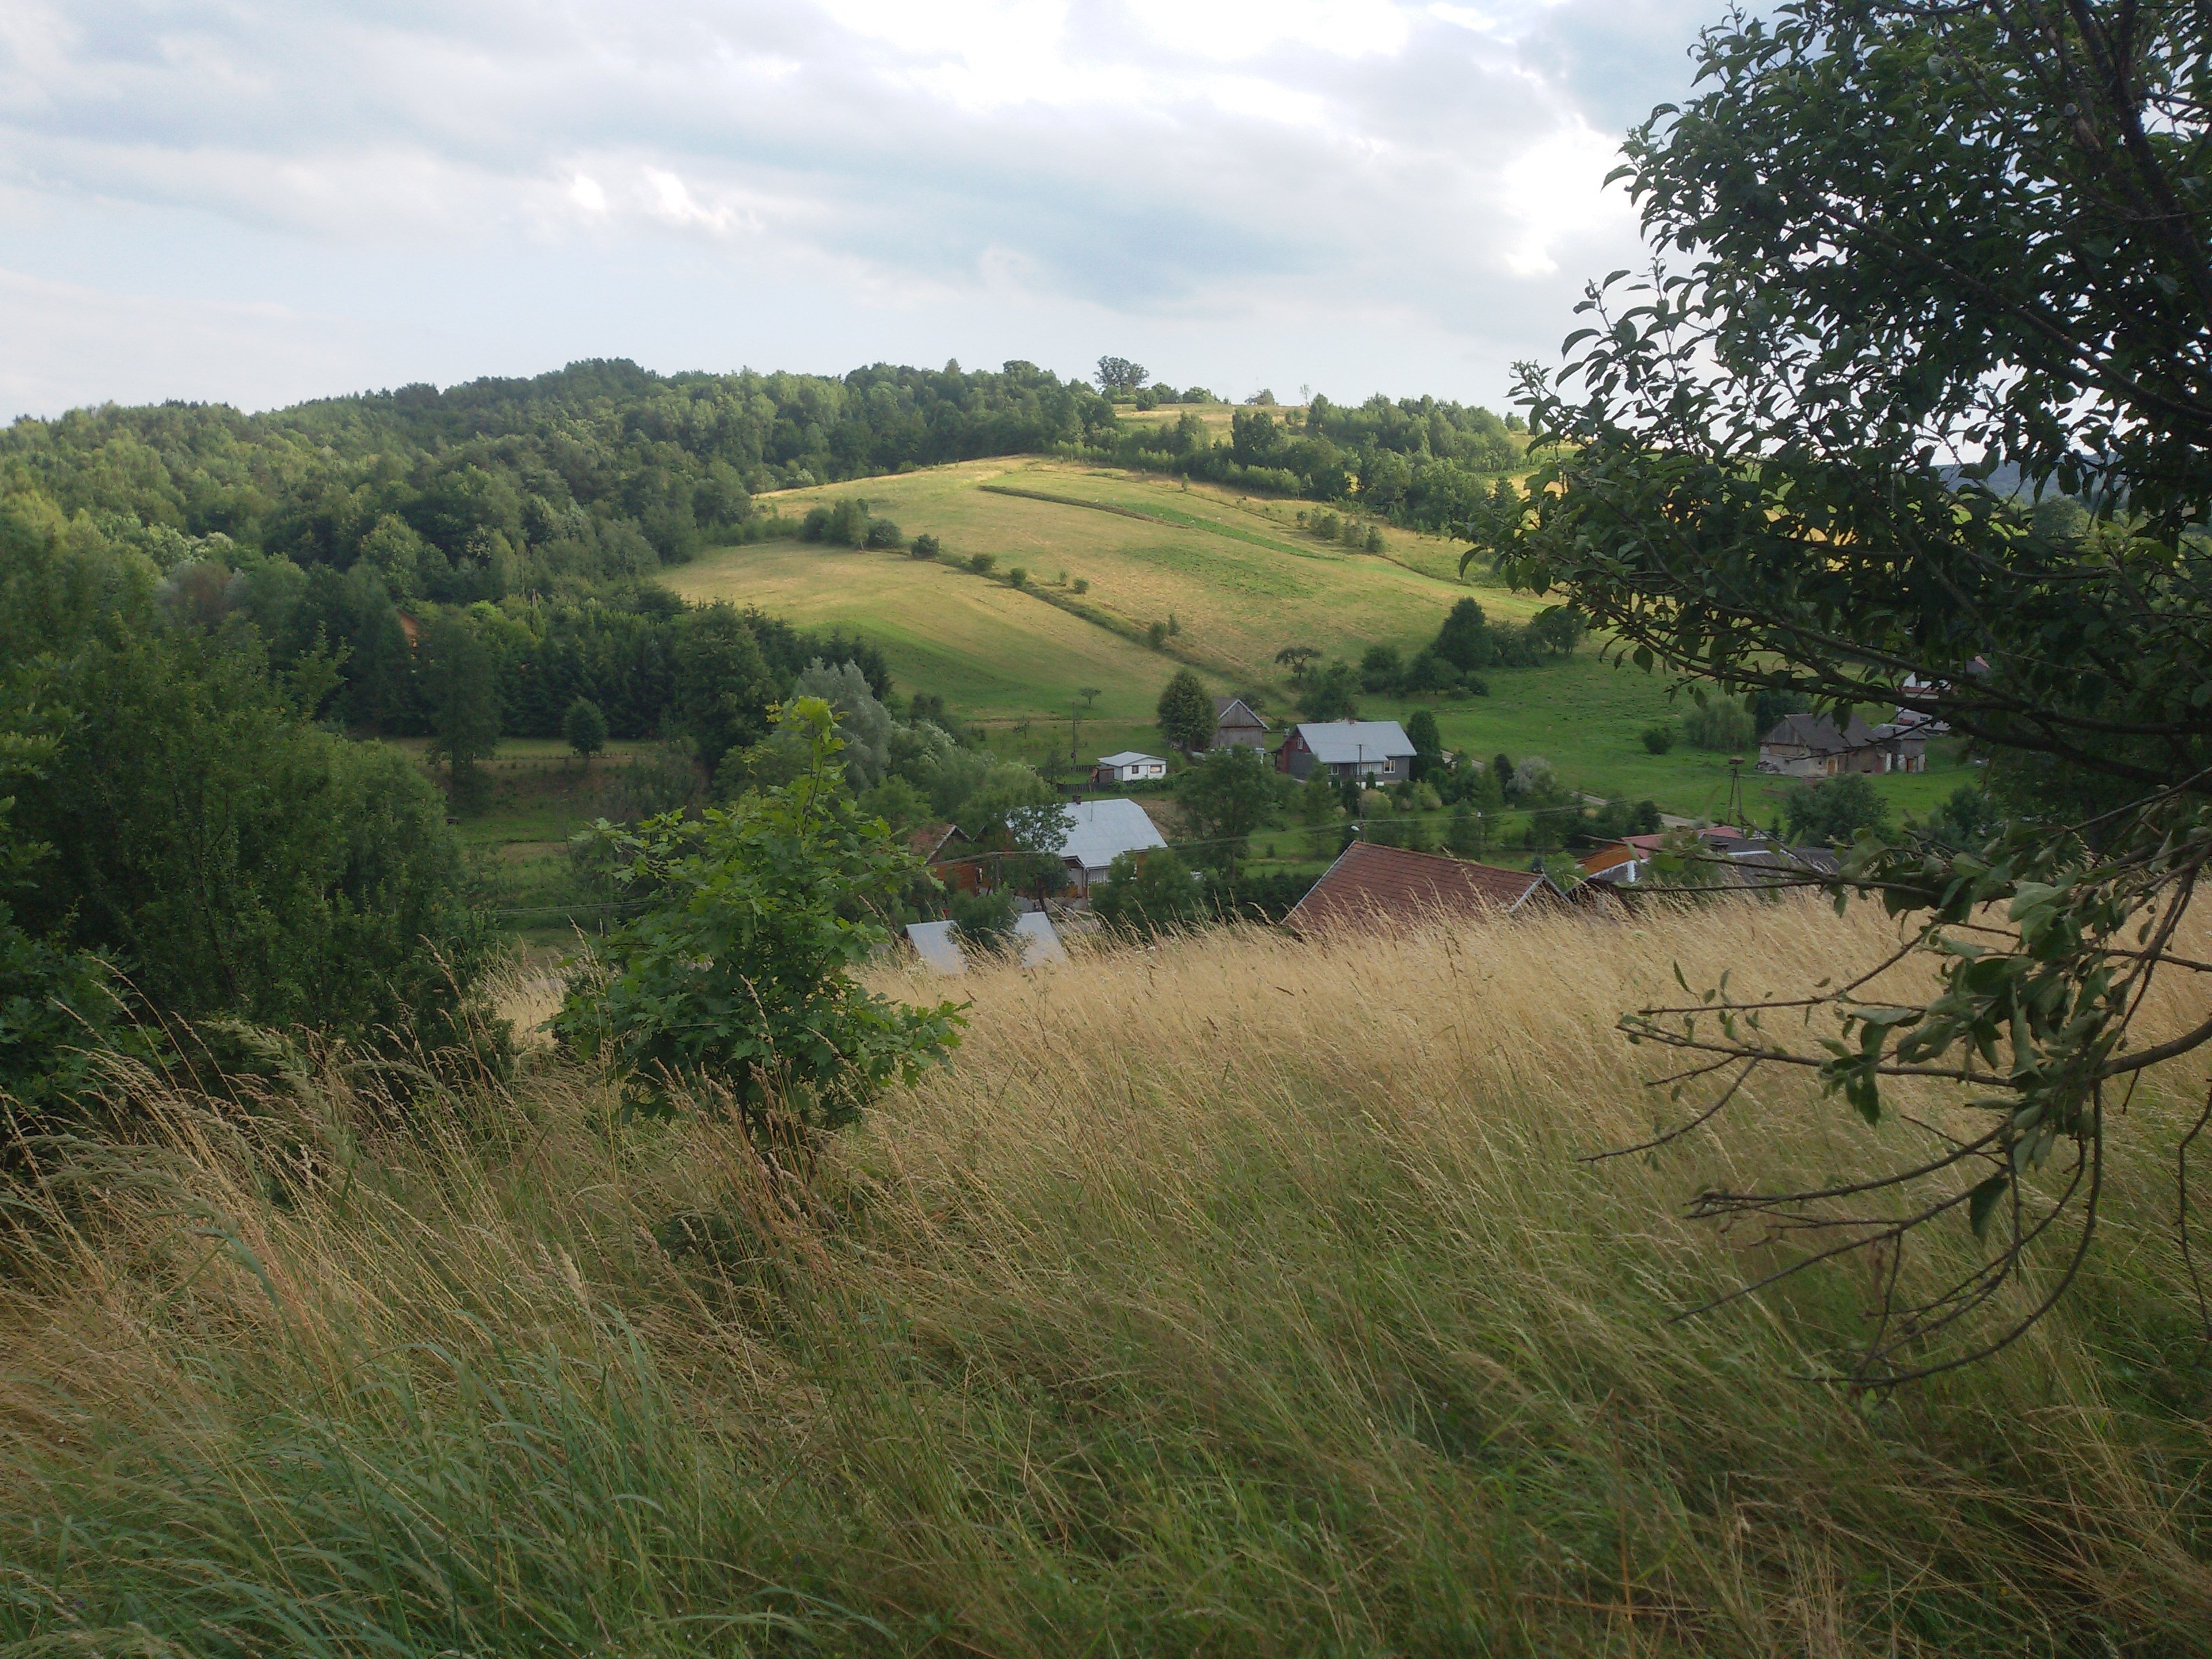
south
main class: Grassland
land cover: Grassland with sparse tree/shrub cover
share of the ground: > 75 %
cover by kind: herbaceous plants 90 %, broadleaved forest trees 5 %, shrubs 5 %
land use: Semi-natural and natural areas not in use
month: July
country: PL
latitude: 49.6673
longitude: 22.2395
